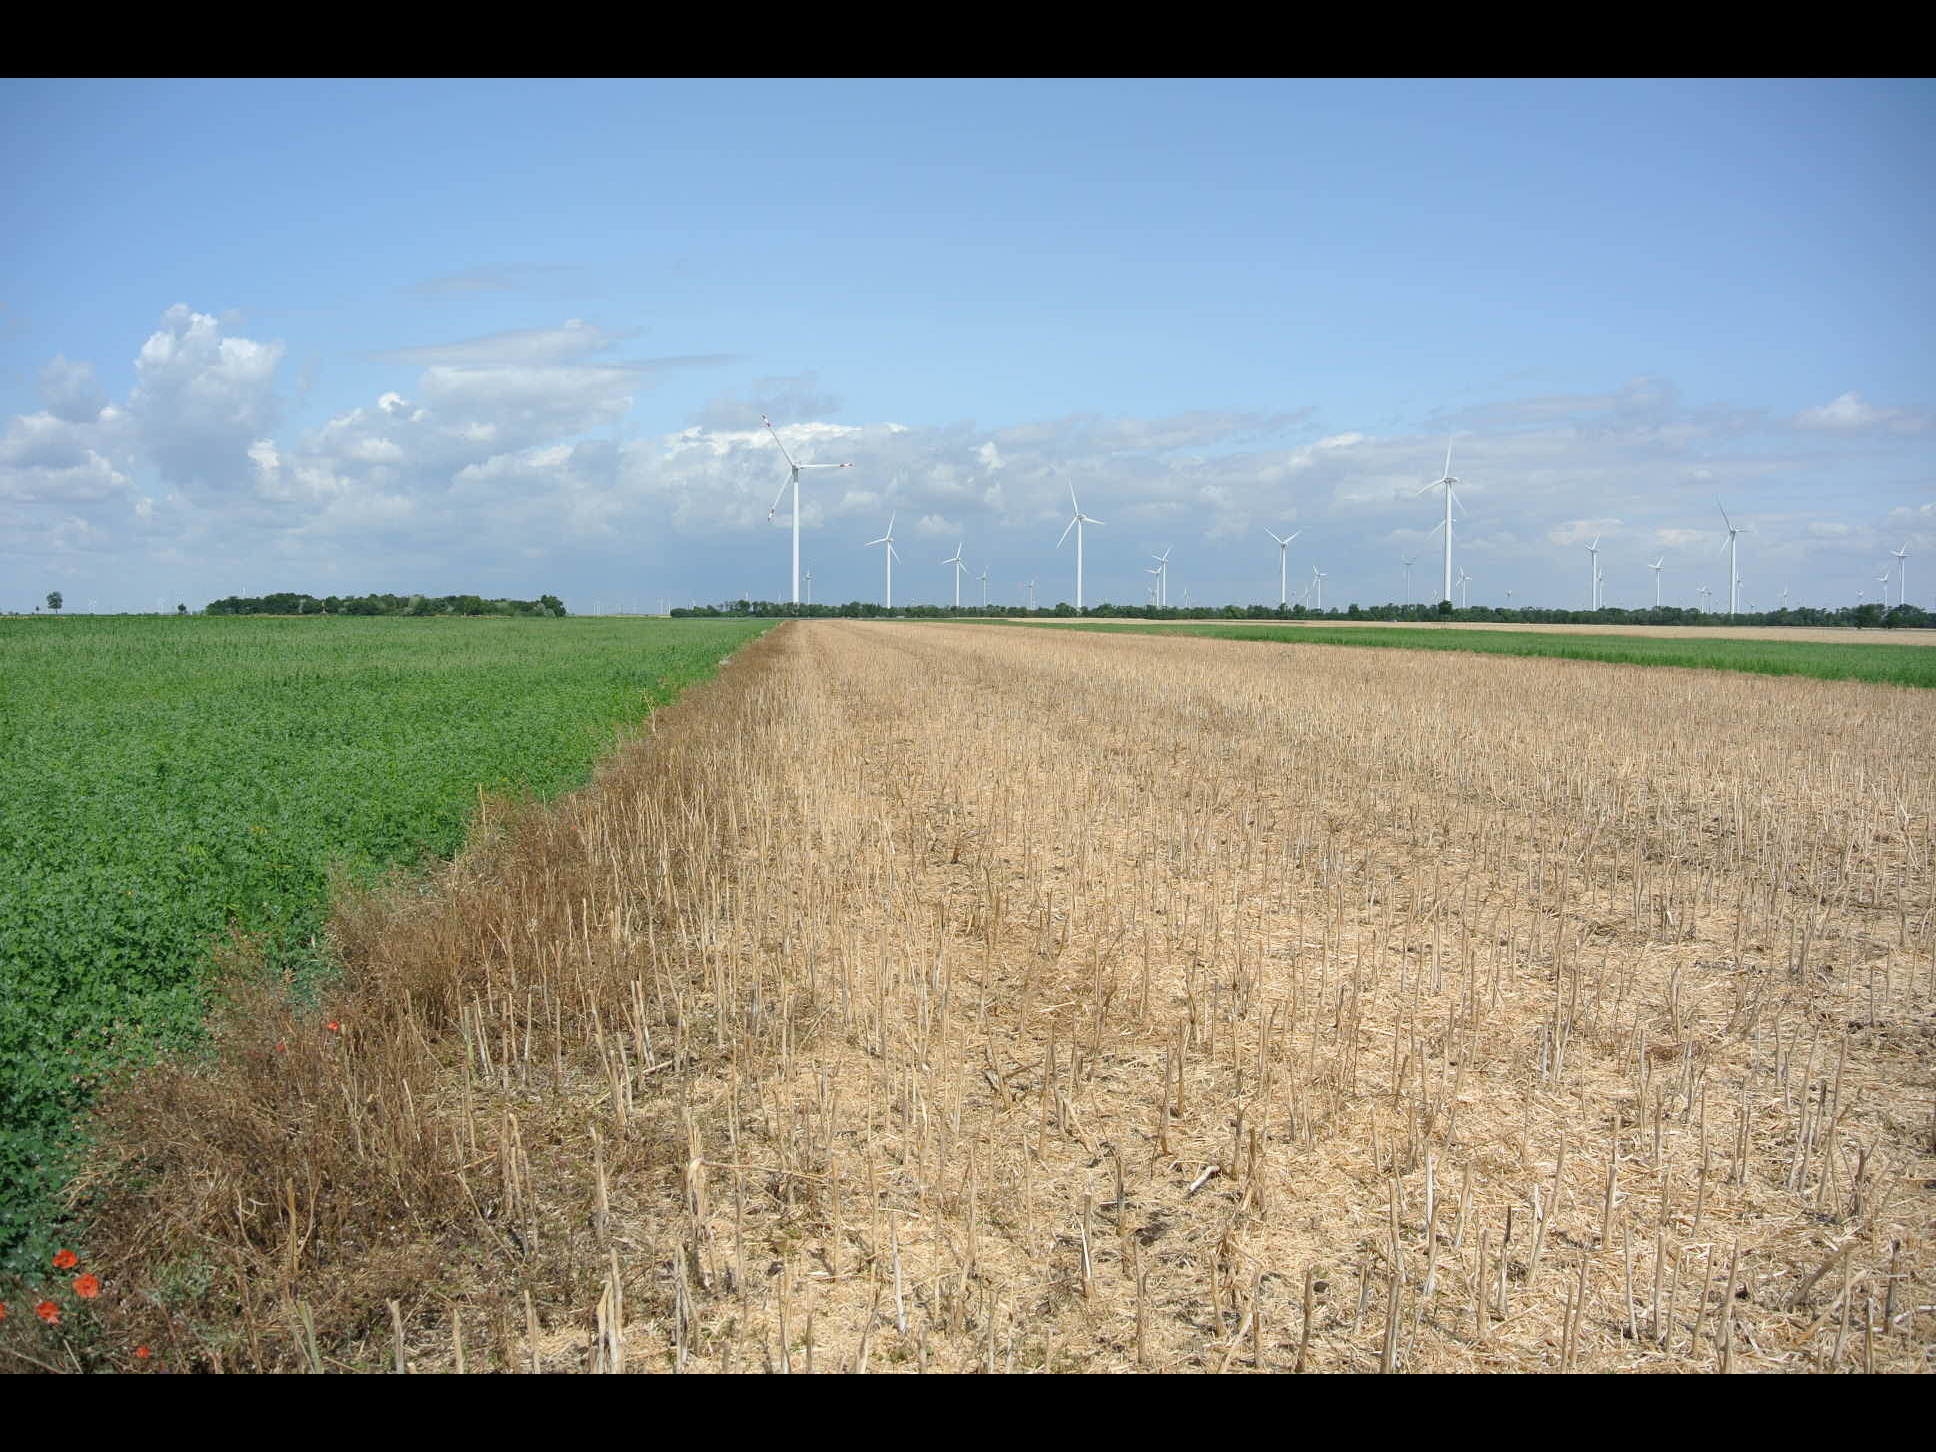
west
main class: Cropland
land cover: Rape and turnip rape
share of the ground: > 75 %
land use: Agriculture (excluding fallow land and kitchen gardens)
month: July
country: AT
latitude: 48.0067
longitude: 16.9099
